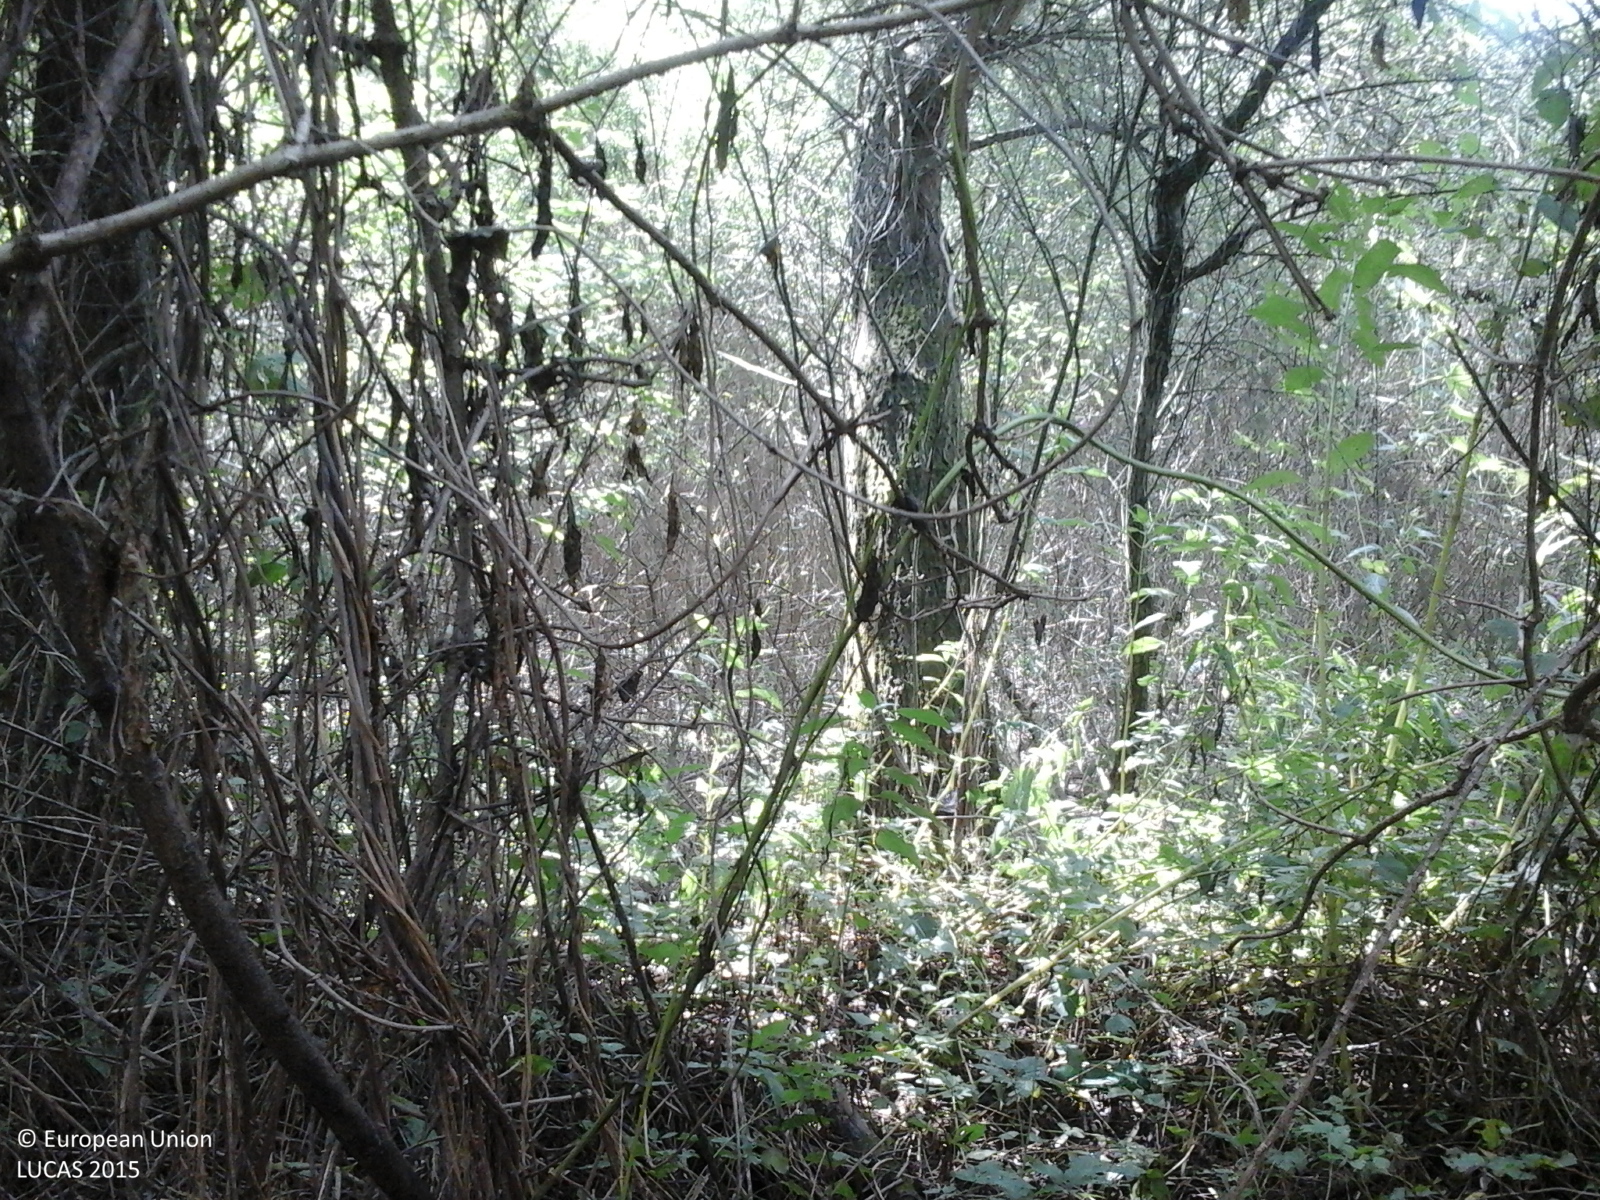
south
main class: Woodland
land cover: Broadleaved woodland
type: non-riverine alder, birch or aspen forest
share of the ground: > 75 %
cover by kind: broadleaved forest trees 100 %
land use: Forestry
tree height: > 5 m
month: September
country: RO
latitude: 47.3364
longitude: 23.4788
